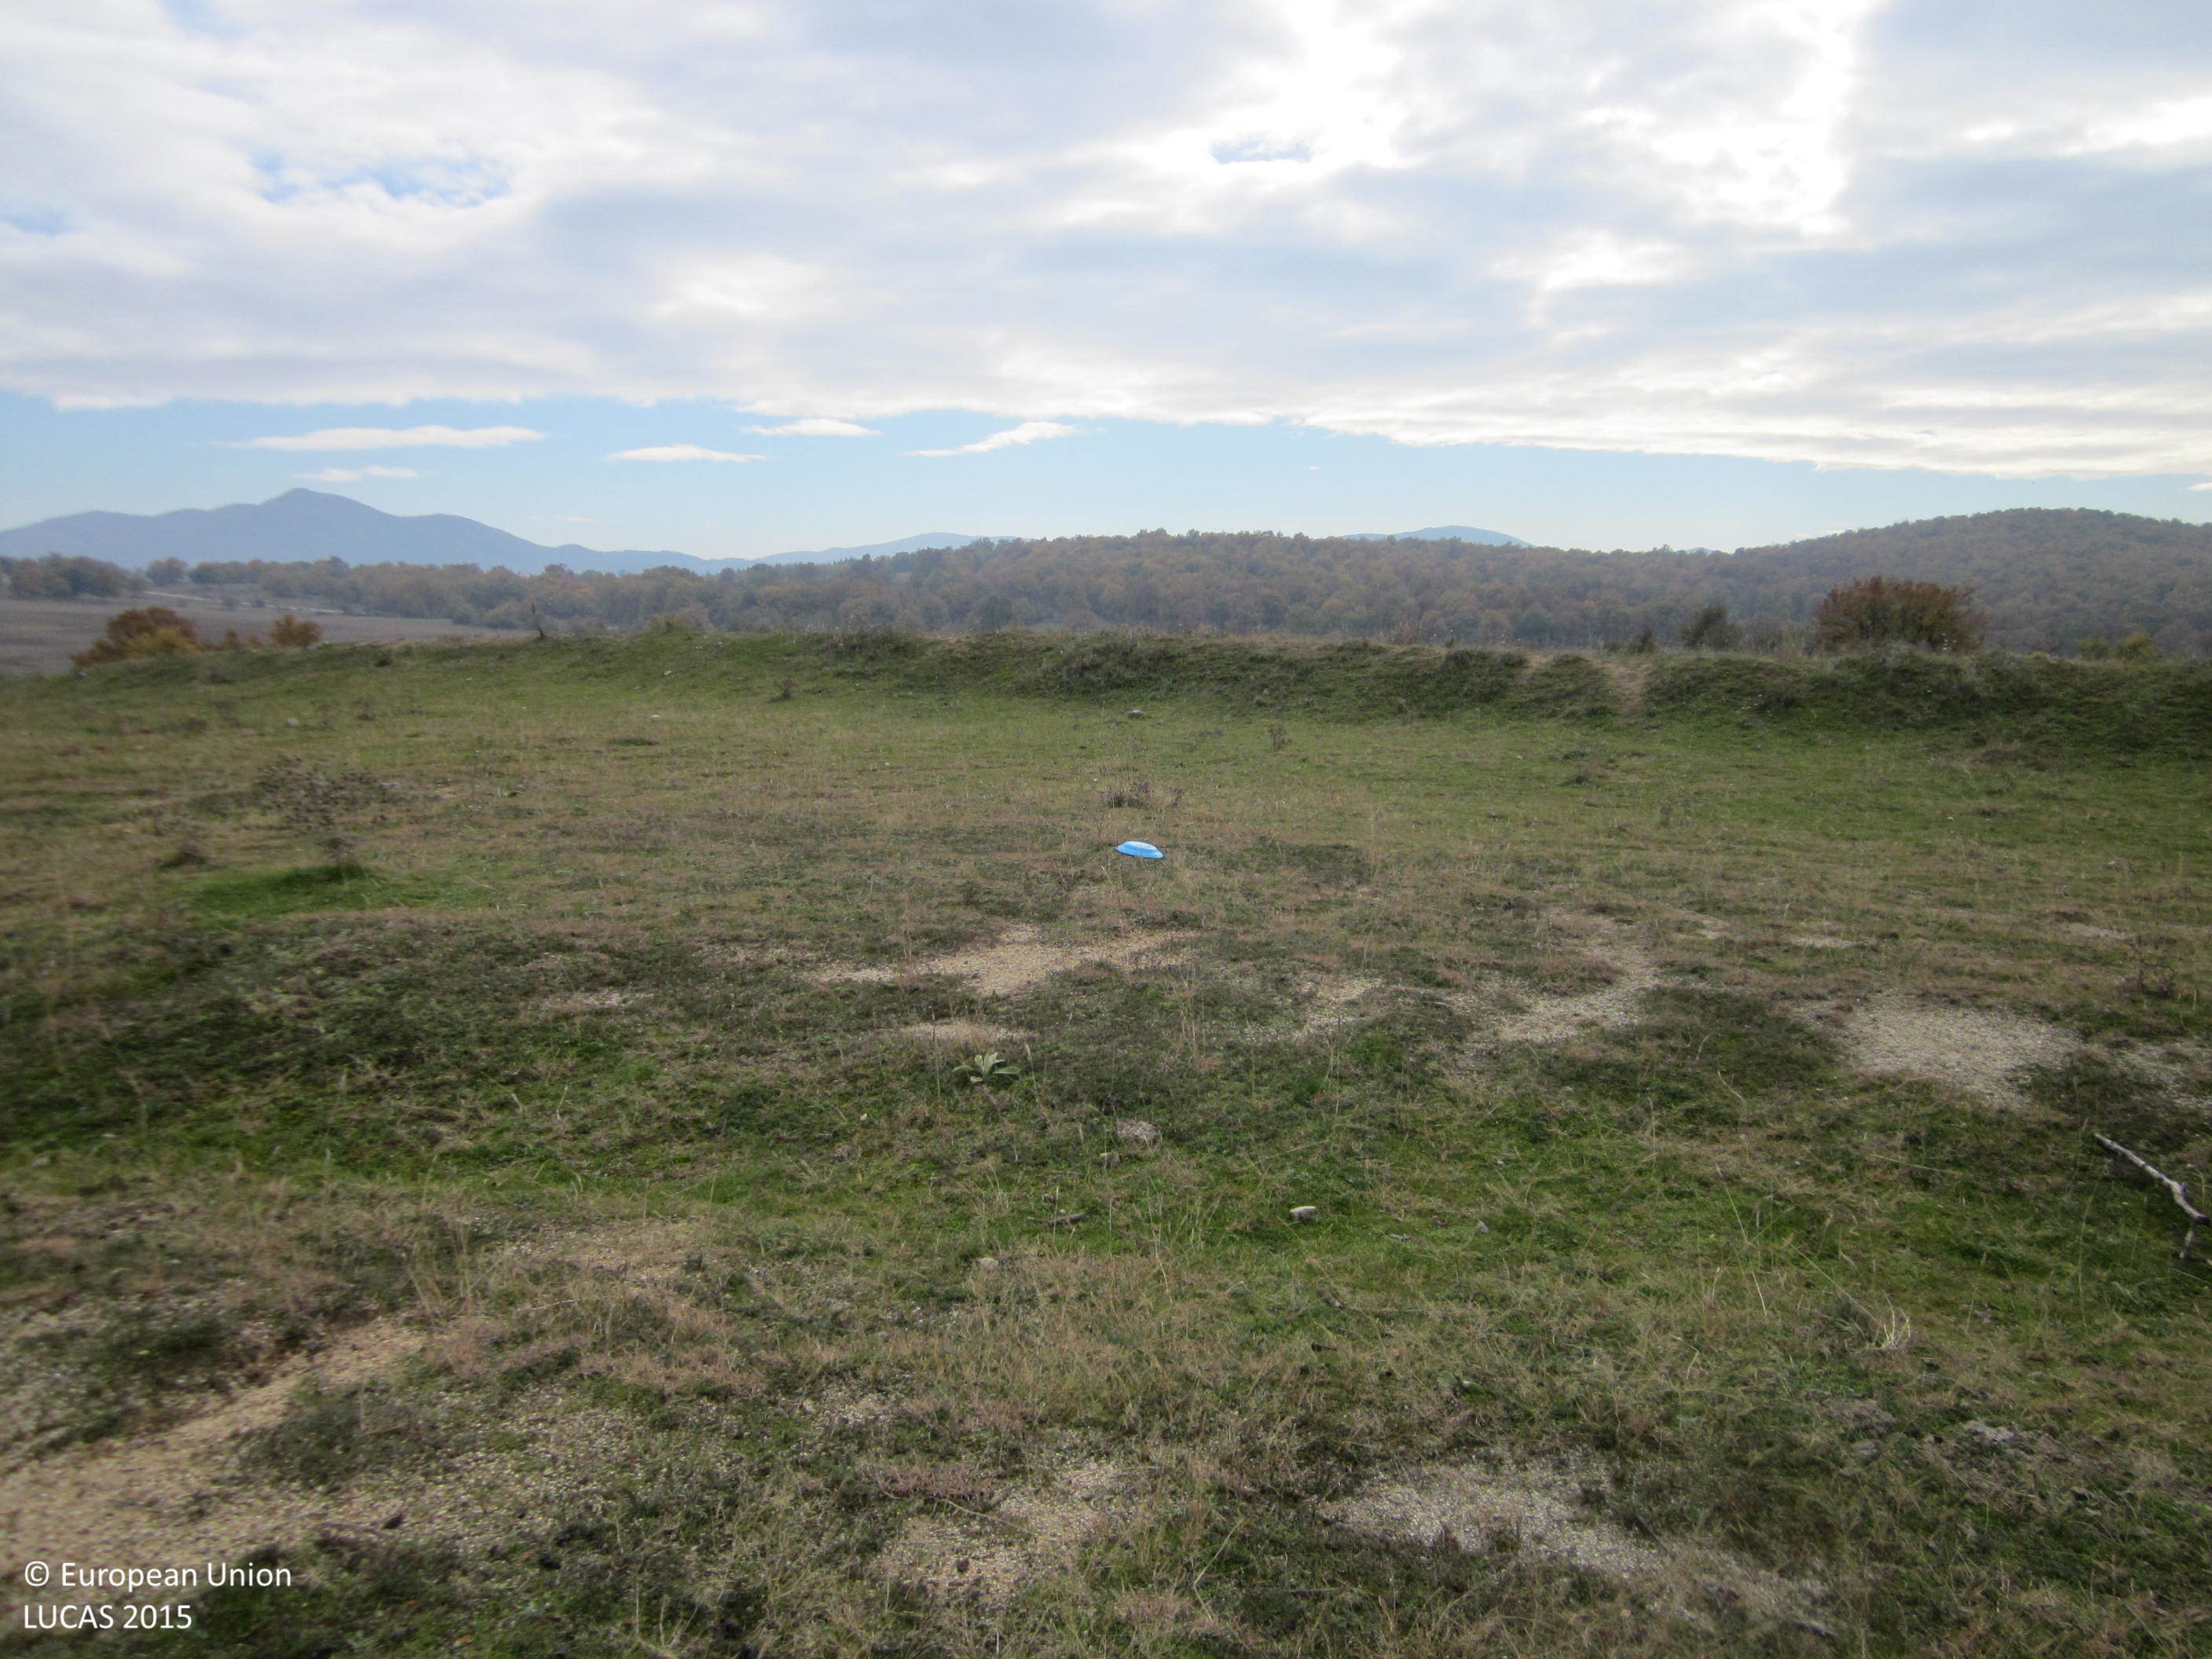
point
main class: Grassland
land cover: Grassland without tree/shrub cover
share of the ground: > 75 %
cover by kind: herbaceous plants 100 %
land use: Agriculture (excluding fallow land and kitchen gardens)
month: November
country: BG
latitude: 42.5700
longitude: 24.9093
